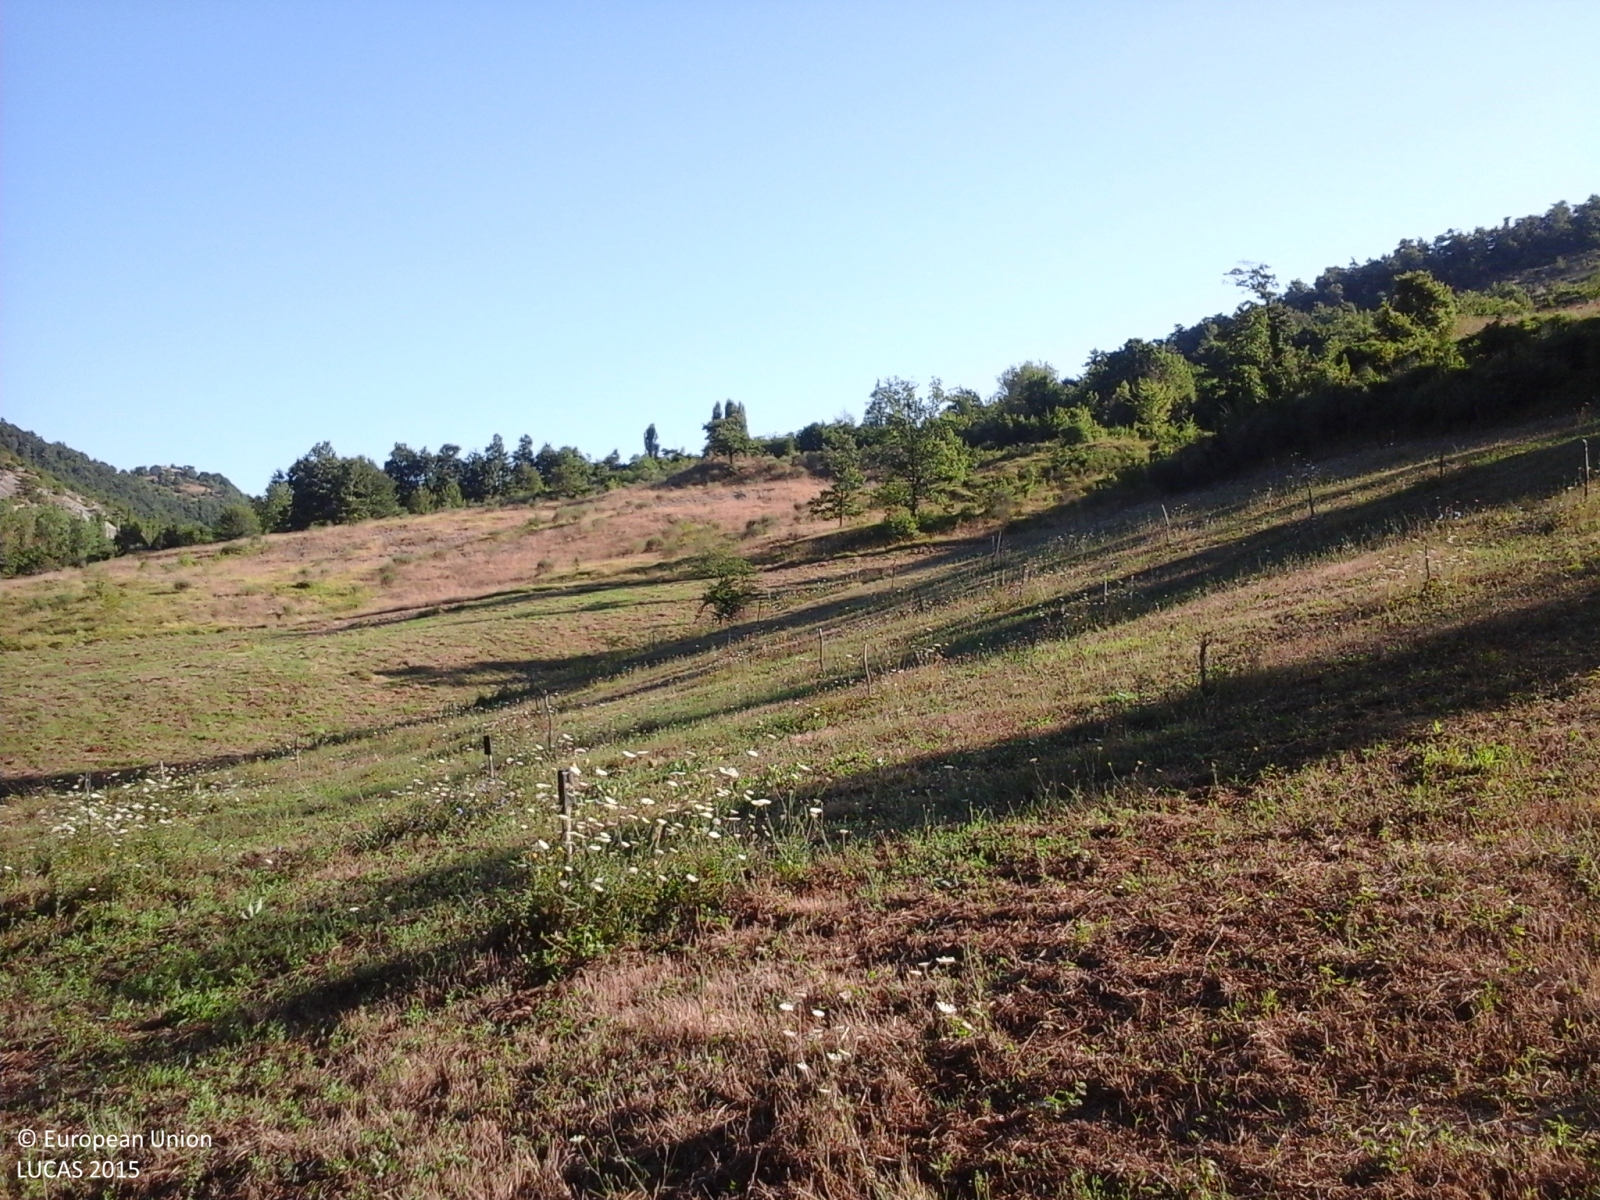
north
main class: Woodland
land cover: Broadleaved woodland
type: thermophilous deciduous forest
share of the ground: > 75 %
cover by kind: broadleaved forest trees 100 %
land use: Semi-natural and natural areas not in use
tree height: > 5 m
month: August
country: IT
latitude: 43.4924
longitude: 12.4050
